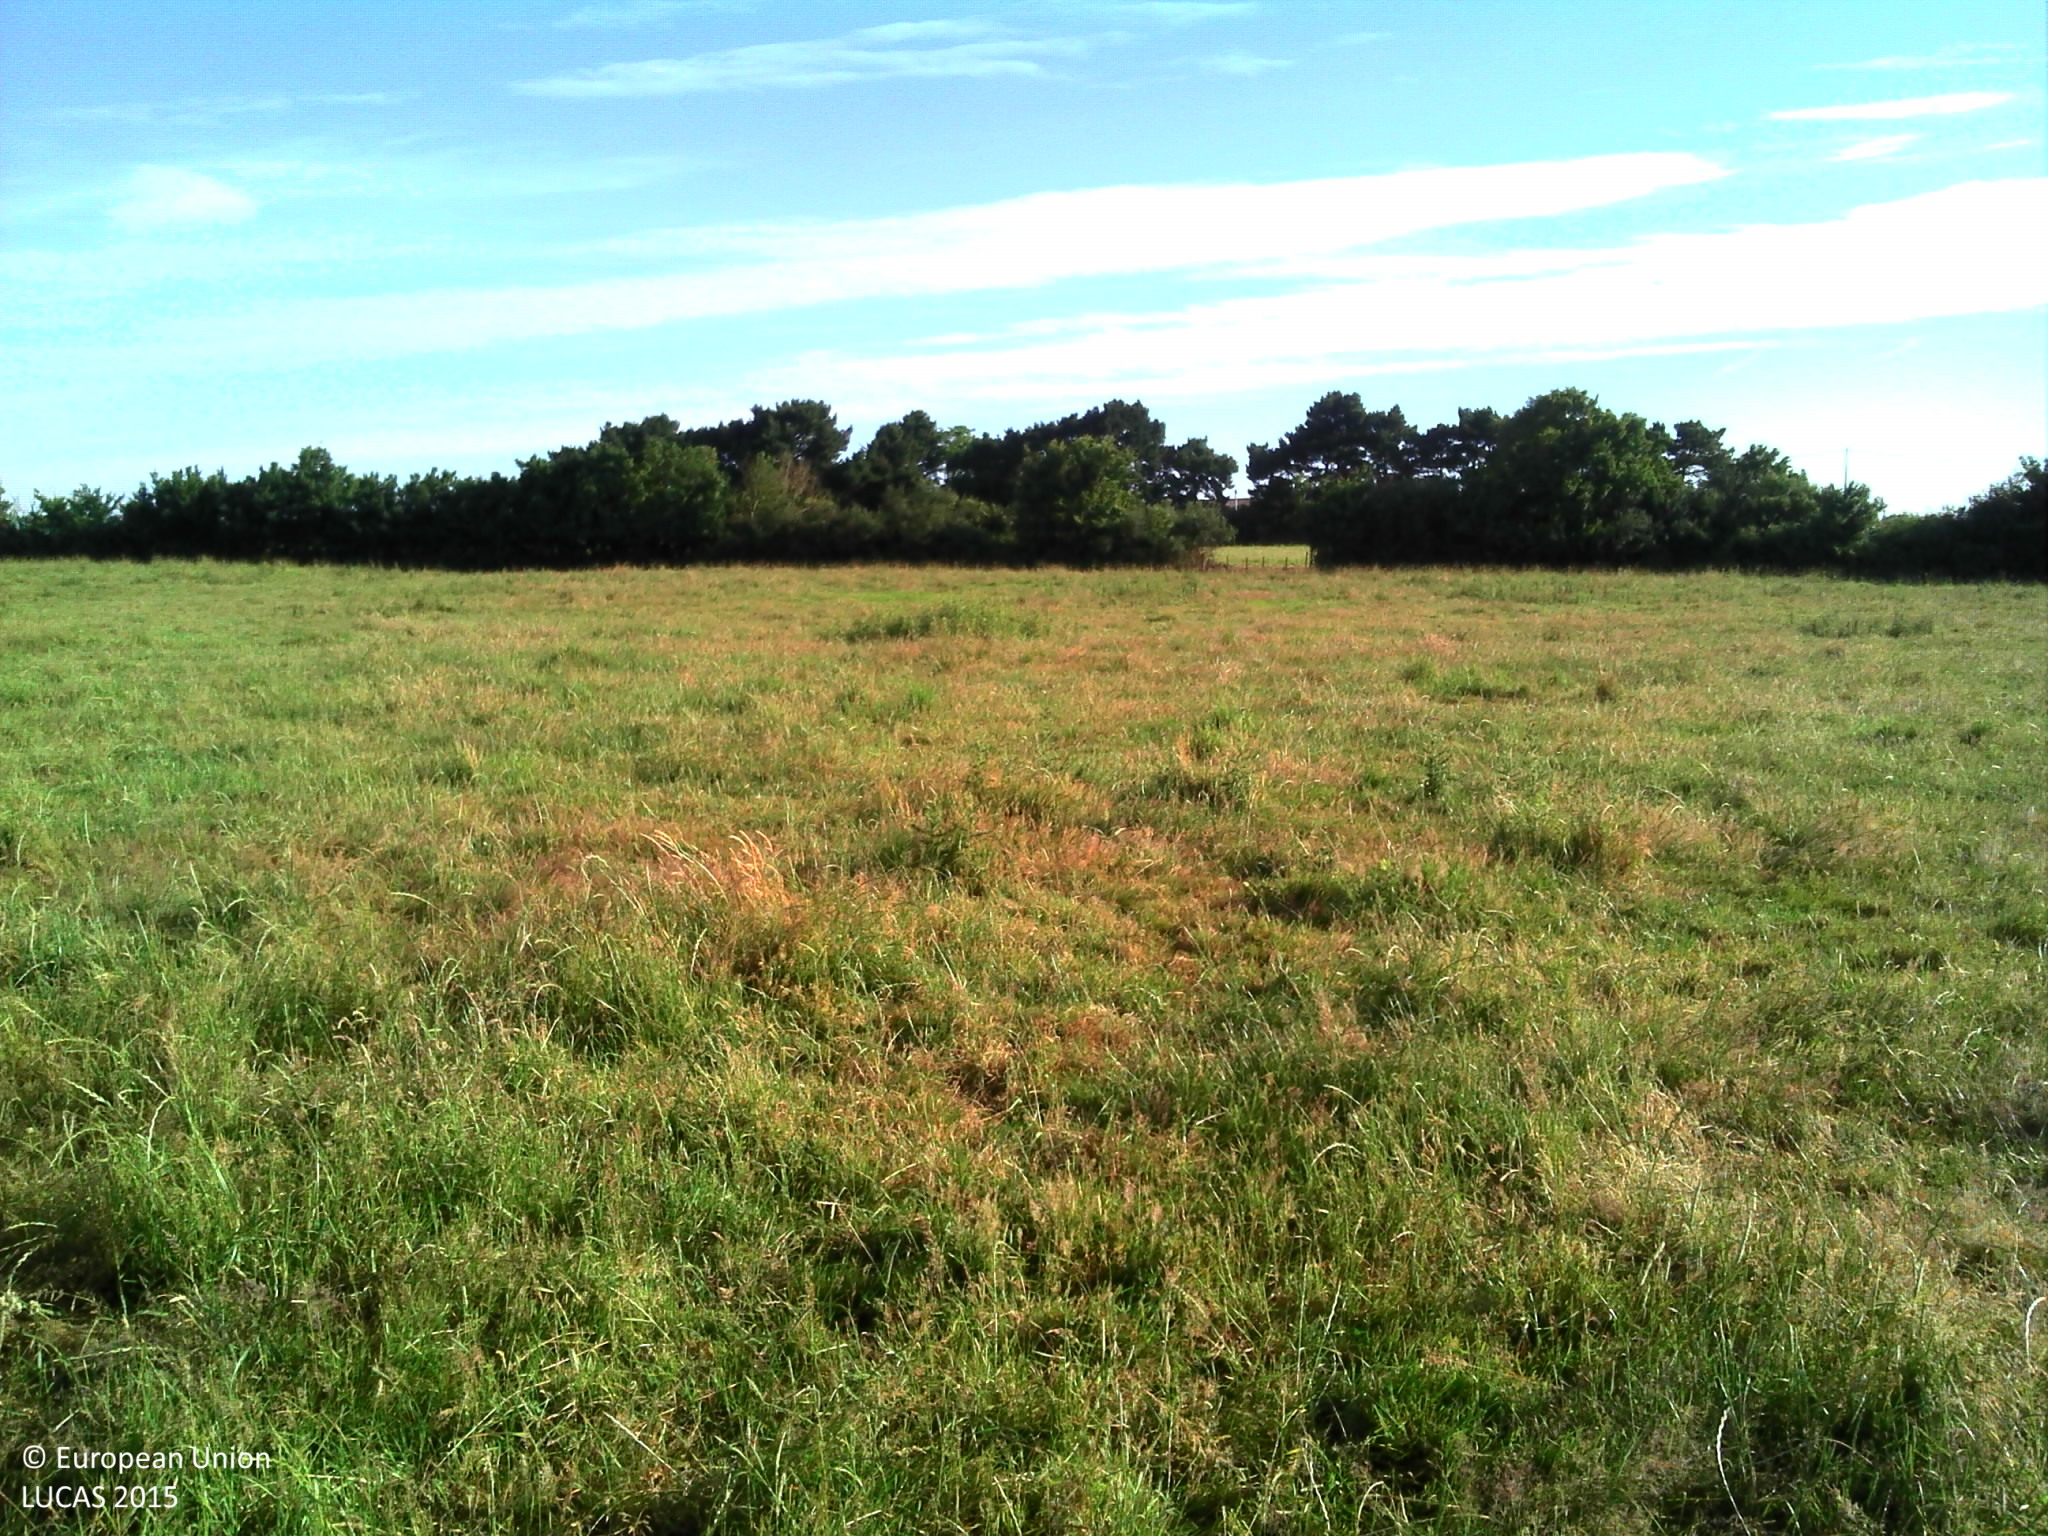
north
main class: Cropland
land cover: Temporary grasslands
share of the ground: > 75 %
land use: Agriculture (excluding fallow land and kitchen gardens)
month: June
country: FR
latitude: 47.2642
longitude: -2.0897
